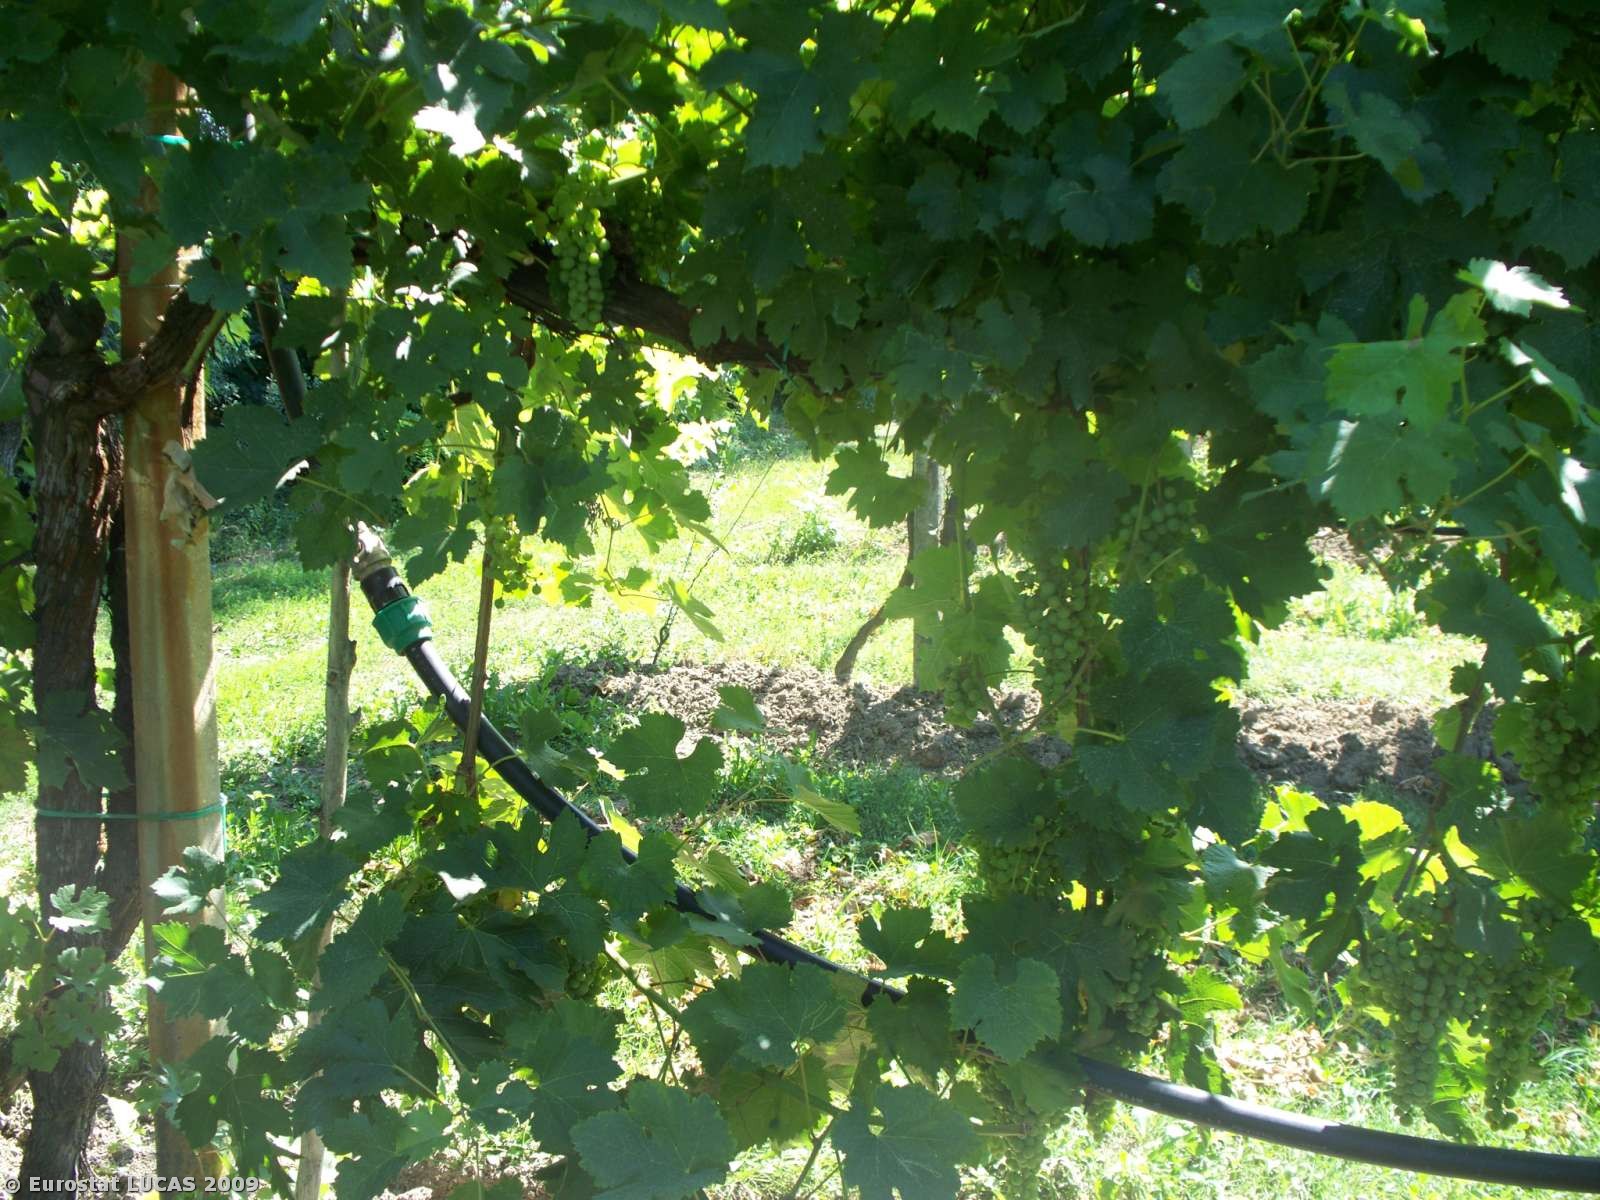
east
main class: Cropland
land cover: Vineyards
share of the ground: 25 - 50 %
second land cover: Grassland with sparse tree/shrub cover
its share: > 75 %
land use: Agriculture (excluding fallow land and kitchen gardens)
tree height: < 5 m
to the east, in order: Vineyards; Grassland with sparse tree/shrub cover; Managed hedges; Ditches and canals; Managed hedges; Grassland without tree/shrub cover; Managed hedges; Ditches and canals; Managed hedges; Vineyards; Grassland with sparse tree/shrub cover; Soya
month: July
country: IT
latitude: 45.7092
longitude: 12.5013
